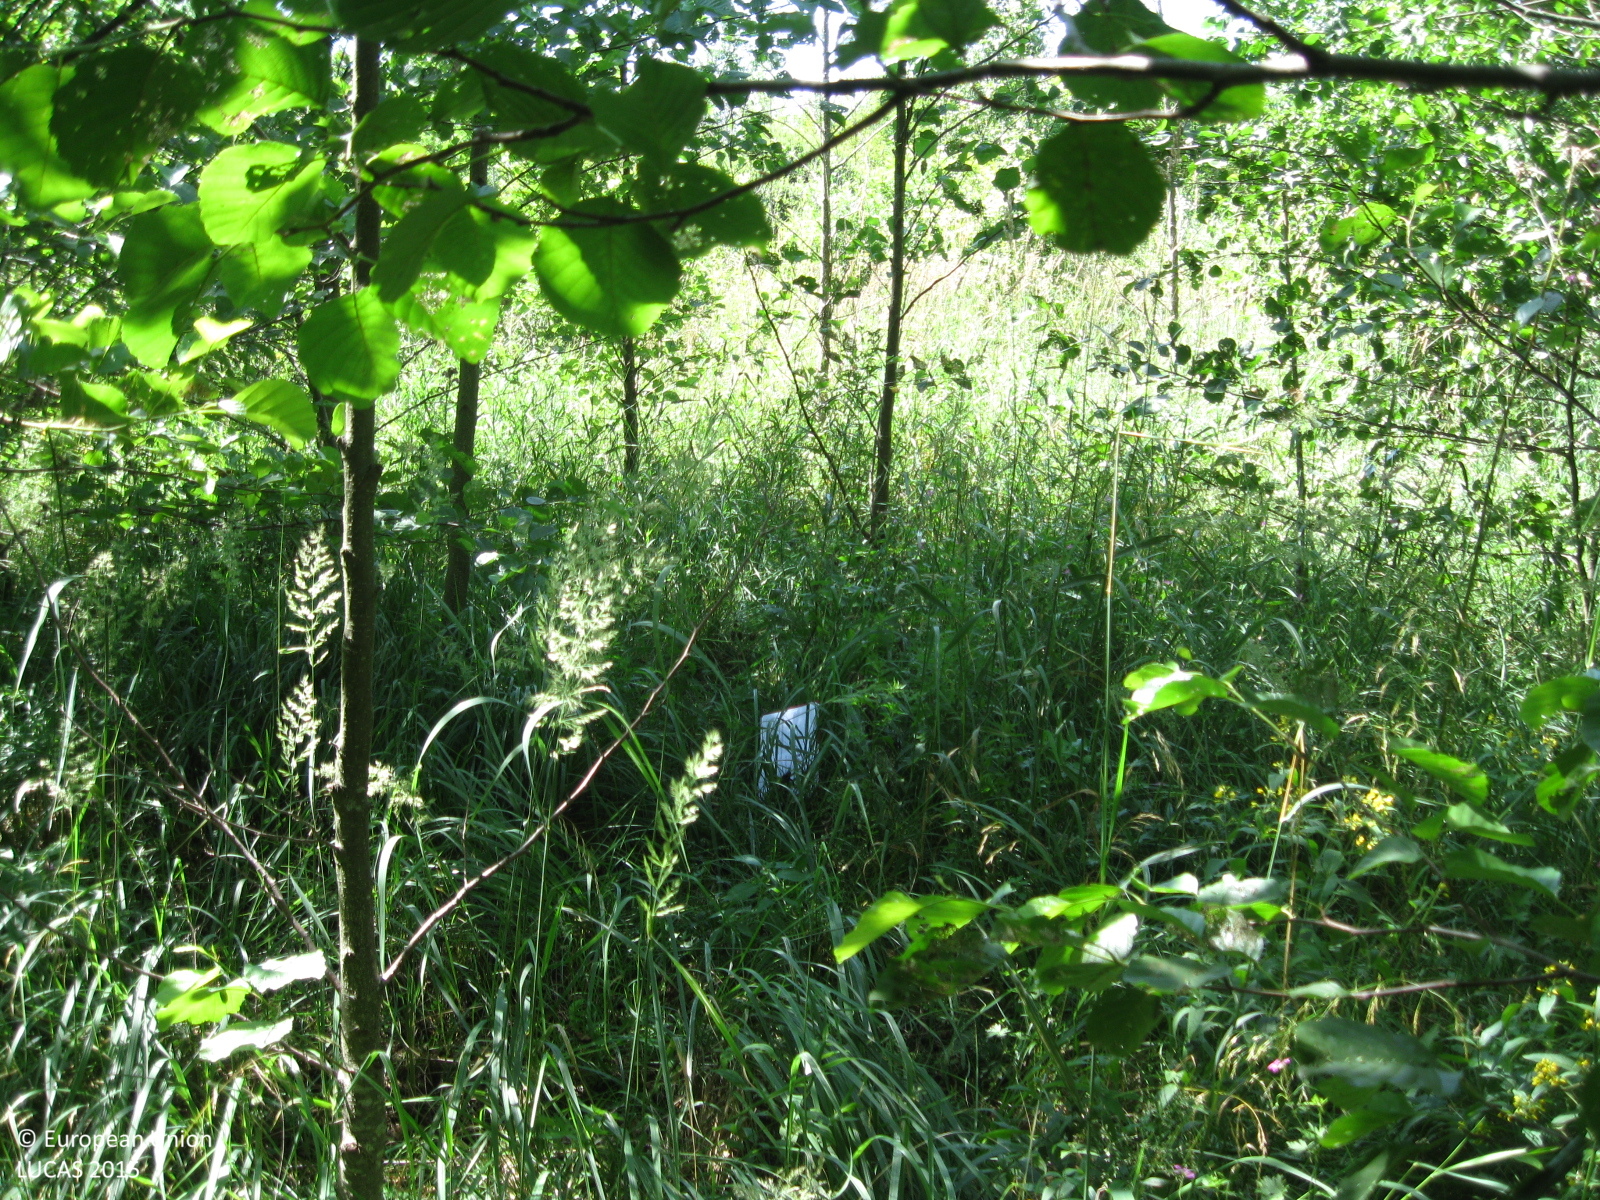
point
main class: Woodland
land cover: Broadleaved woodland
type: non-riverine alder, birch or aspen forest
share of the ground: > 75 %
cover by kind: broadleaved forest trees 75 %, herbaceous plants 25 %
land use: Forestry
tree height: > 5 m
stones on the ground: < 10 %
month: July
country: LT
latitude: 55.1394
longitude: 24.6470
